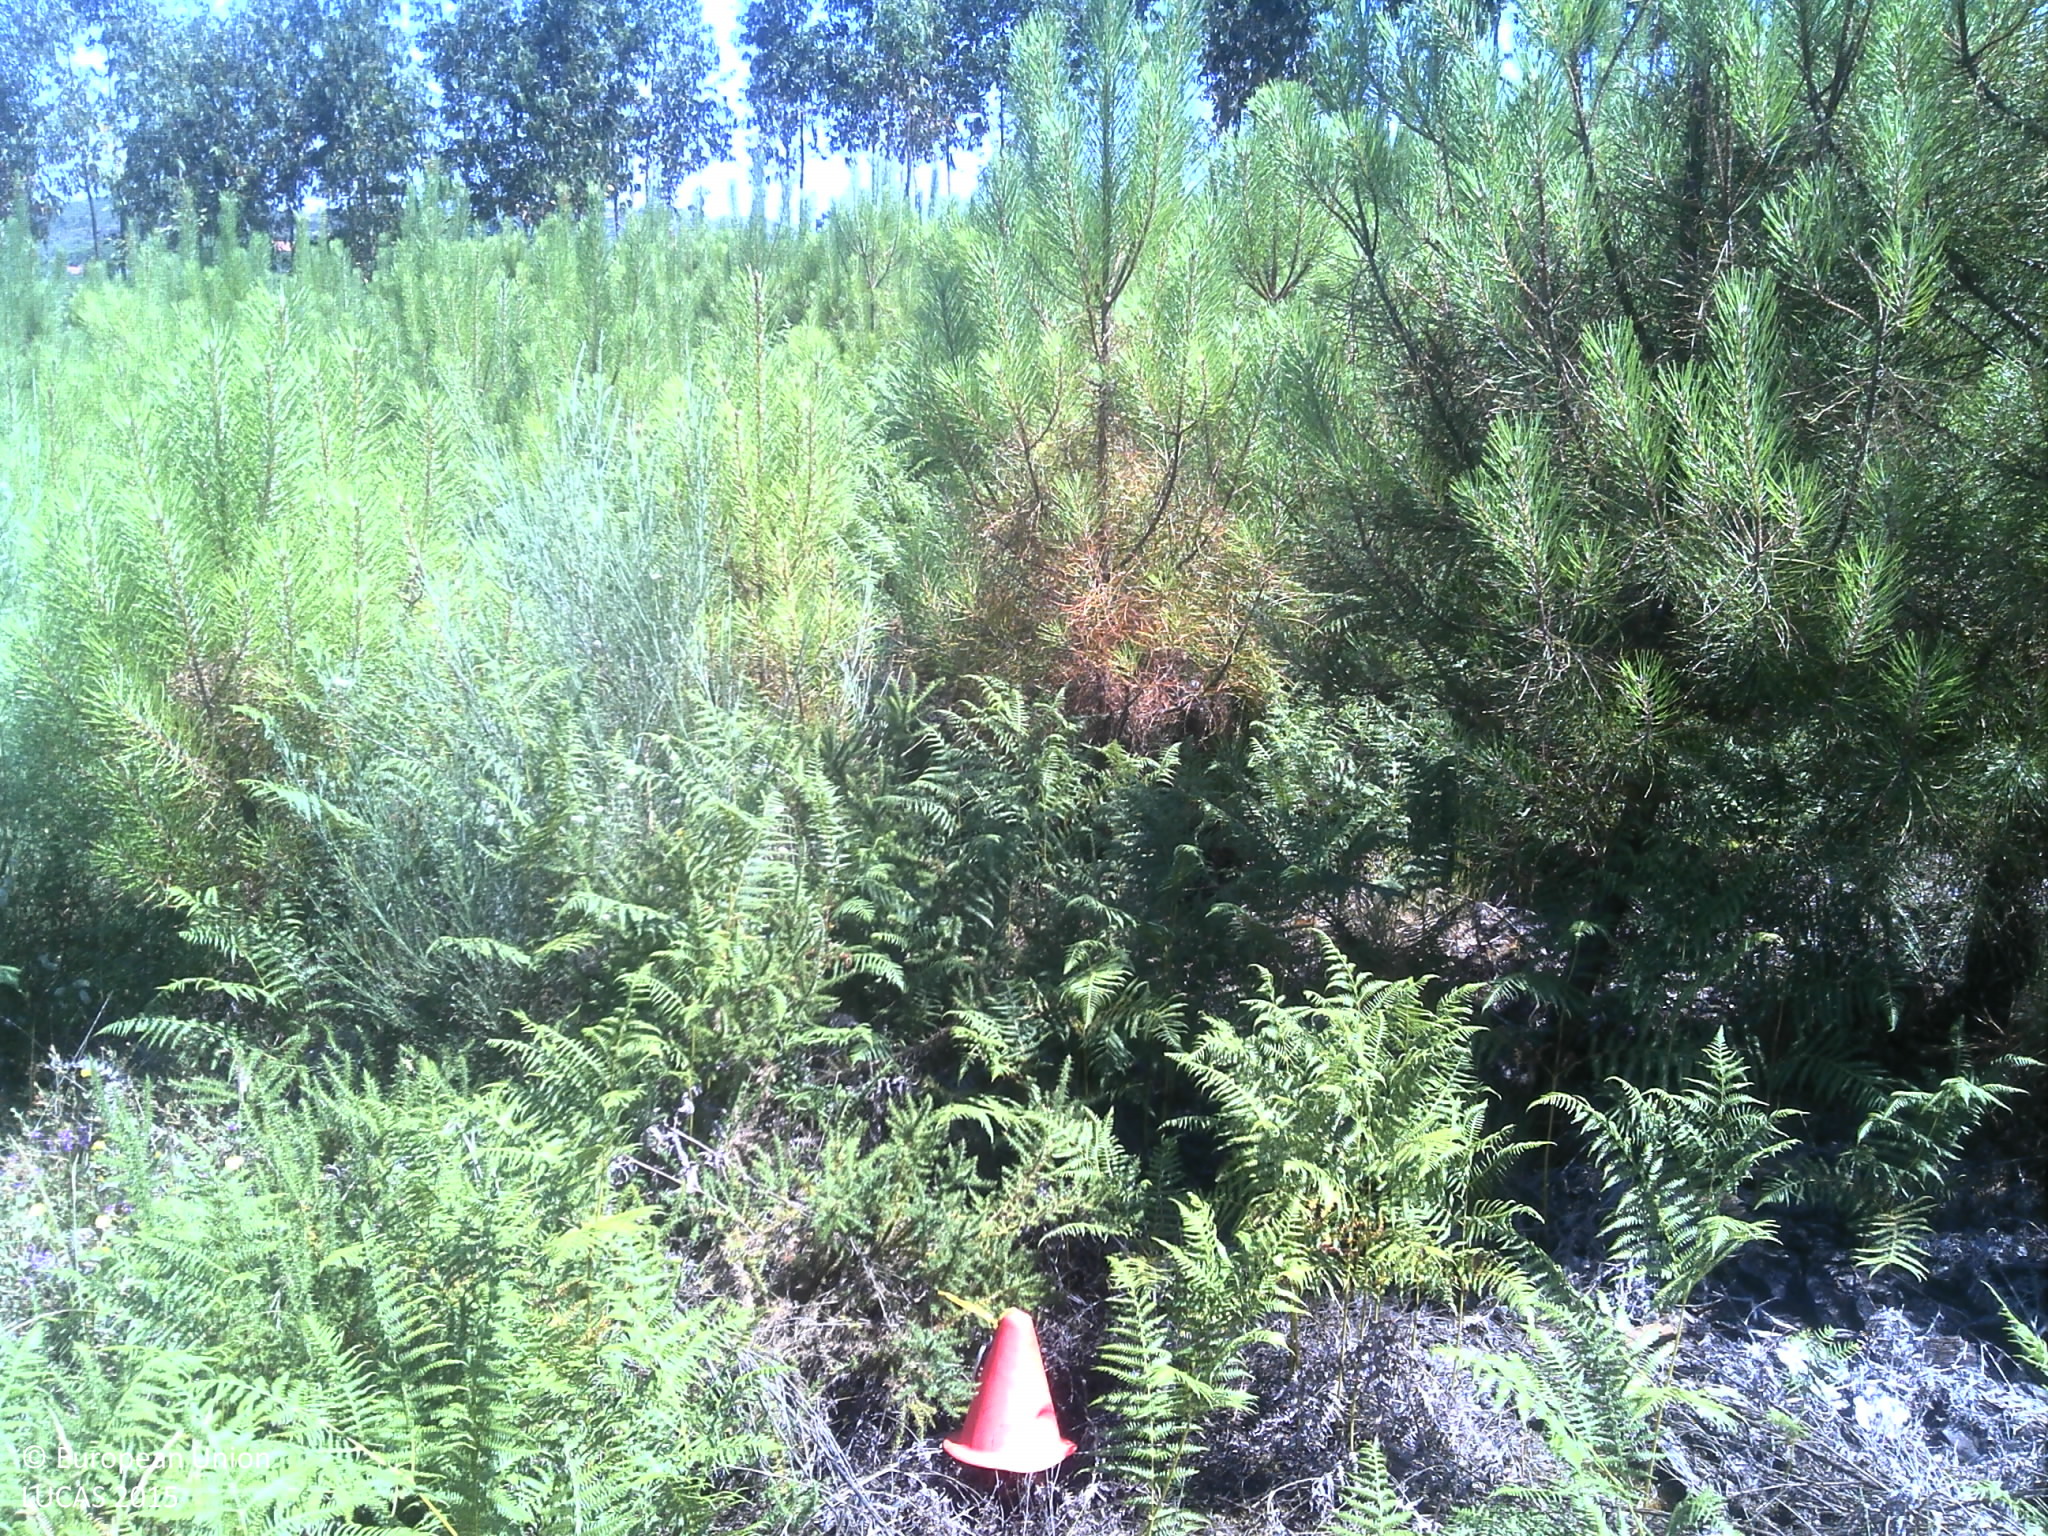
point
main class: Woodland
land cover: Pine dominated coniferous woodland
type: coniferous forest of the mediterranean region
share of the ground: 50 - 75 %
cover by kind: coniferous forest trees 70 %, shrubs 25 %, herbaceous plants 5 %
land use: Forestry
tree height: < 5 m
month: June
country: PT
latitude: 41.4353
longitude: -8.0814
